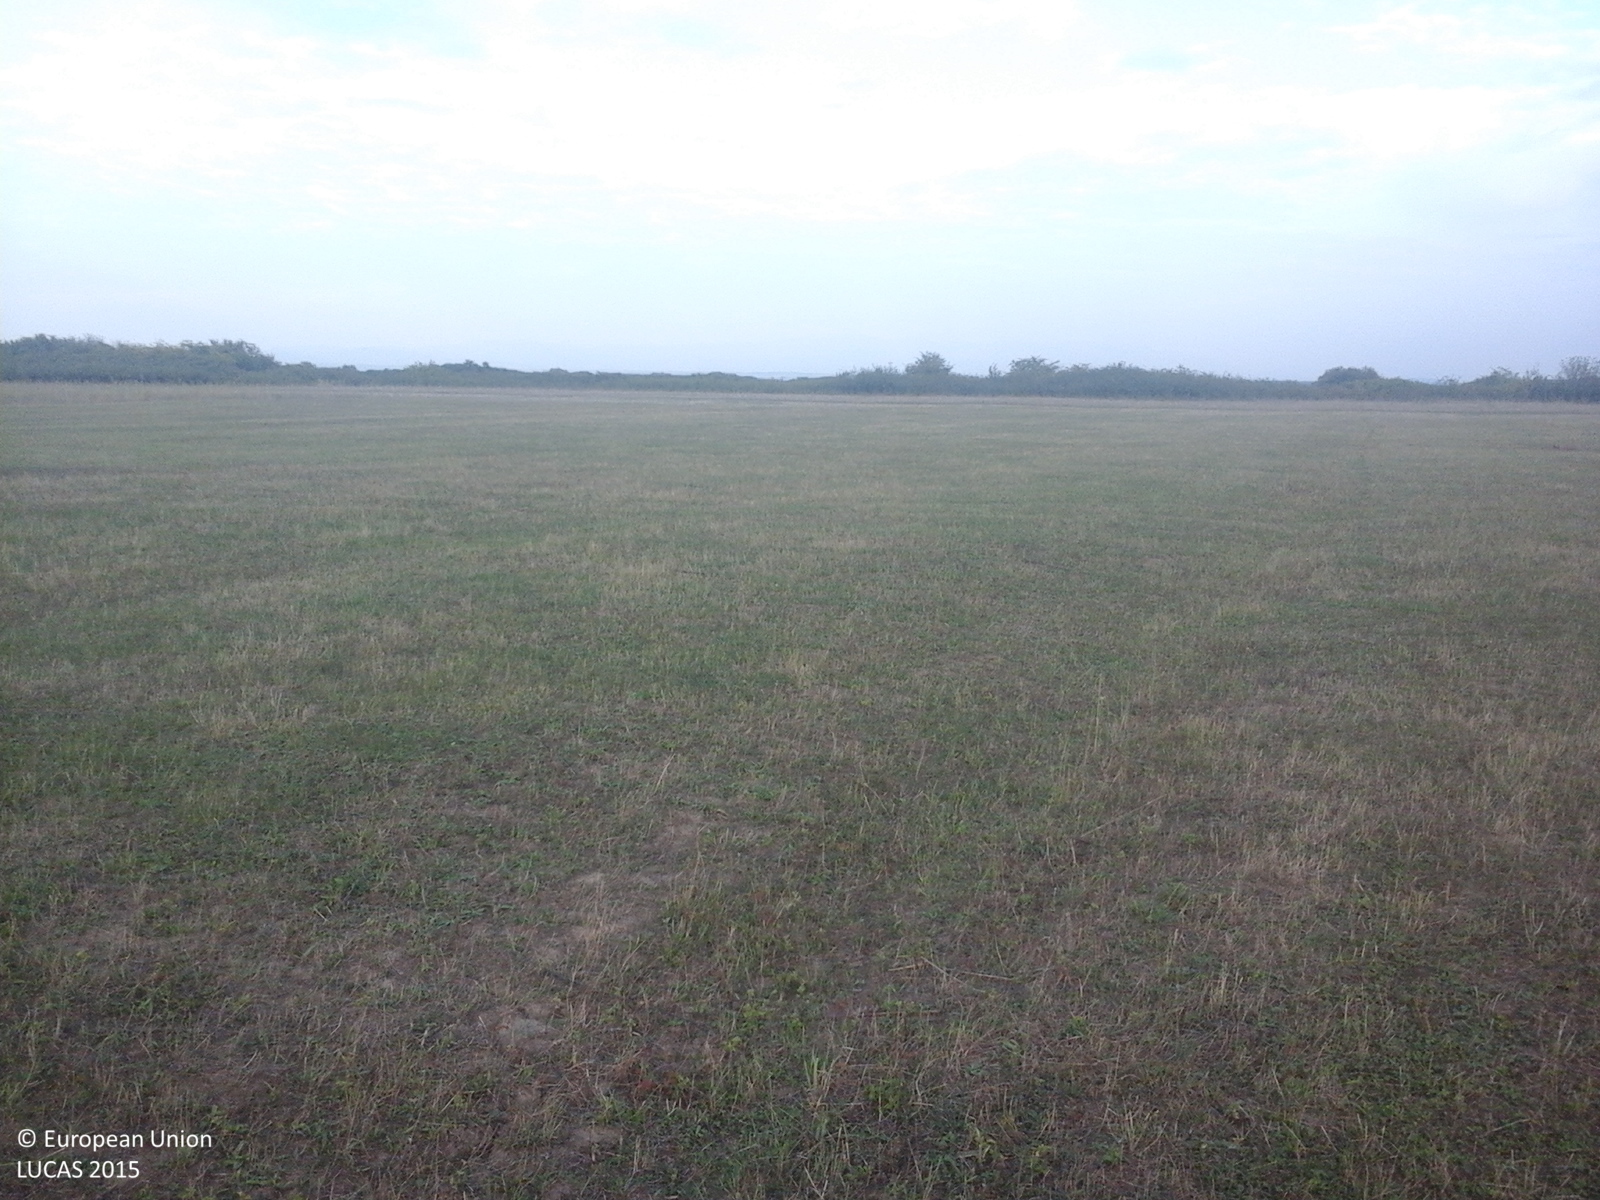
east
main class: Grassland
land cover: Grassland without tree/shrub cover
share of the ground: > 75 %
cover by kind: herbaceous plants 100 %
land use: Agriculture (excluding fallow land and kitchen gardens)
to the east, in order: Grassland without tree/shrub cover; Tracks; Grassland without tree/shrub cover; Shrubland with sparse tree cover; Grassland without tree/shrub cover
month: August
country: RO
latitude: 46.5159
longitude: 21.7852
